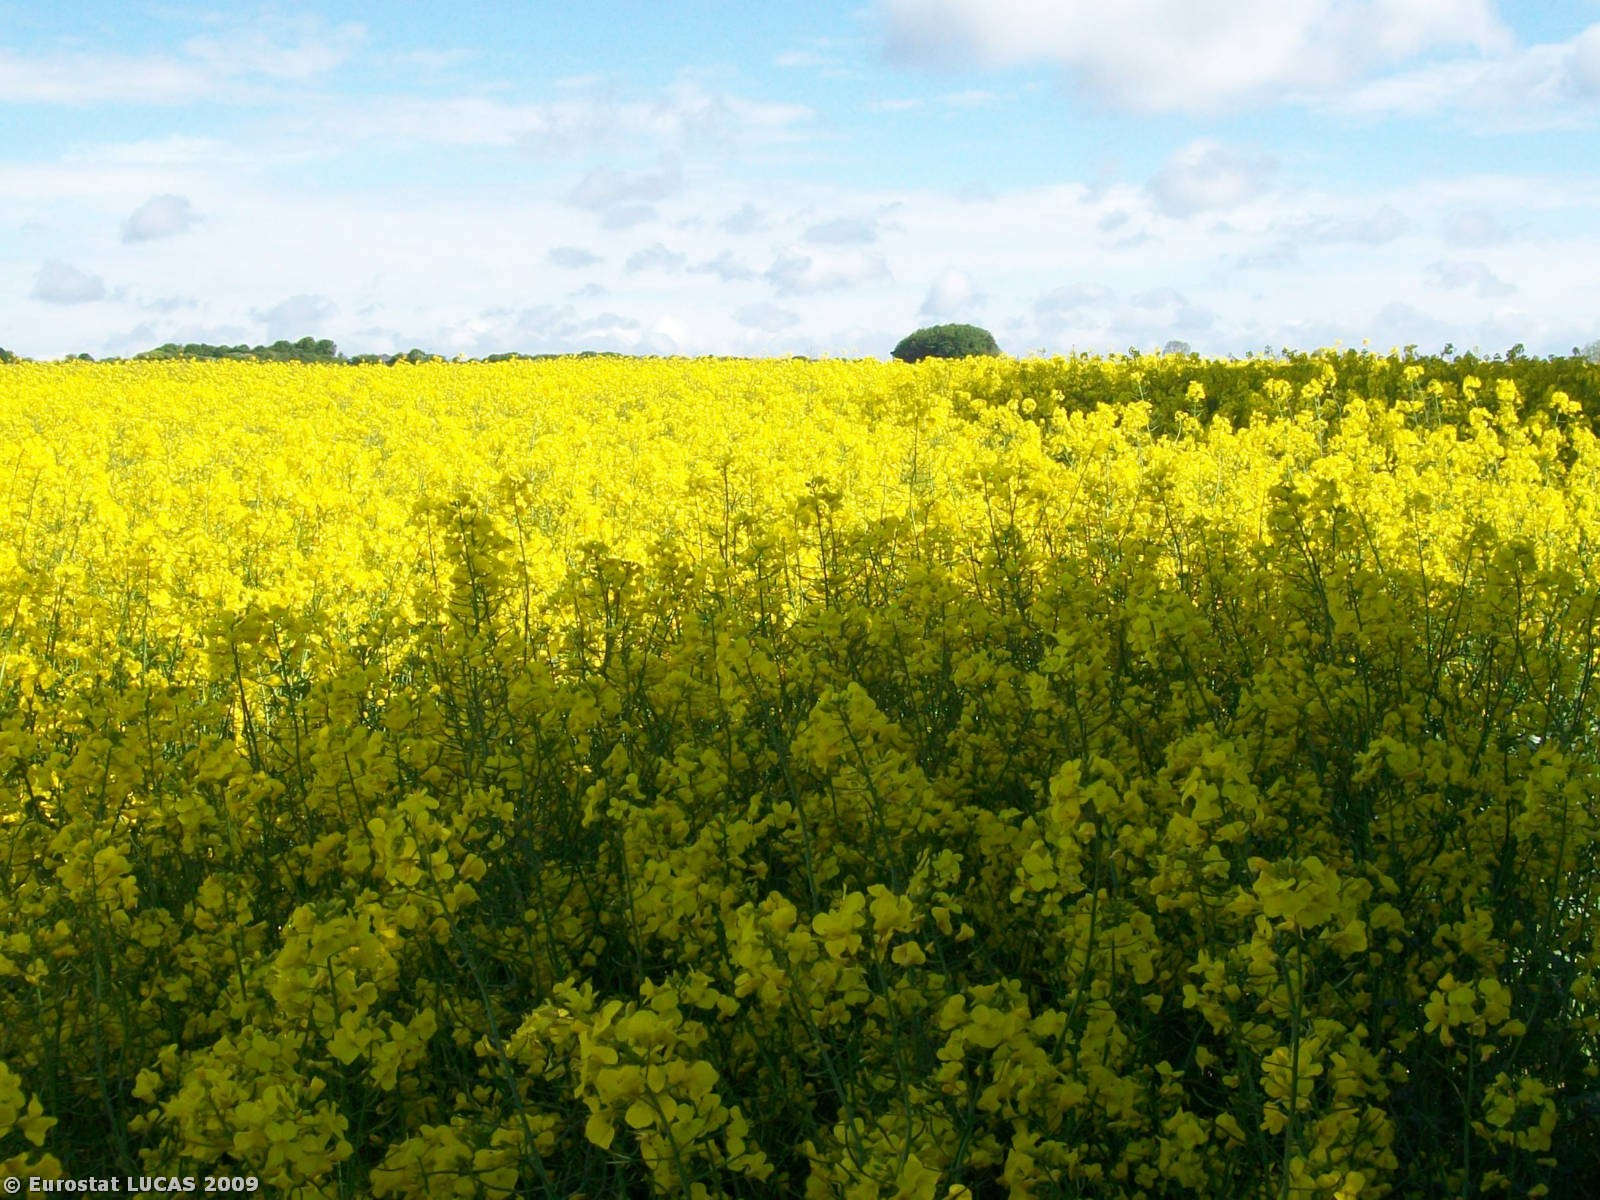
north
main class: Cropland
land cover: Rape and turnip rape
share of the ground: > 75 %
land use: Agriculture (excluding fallow land and kitchen gardens)
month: May
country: GB
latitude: 51.0922
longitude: -2.1833
